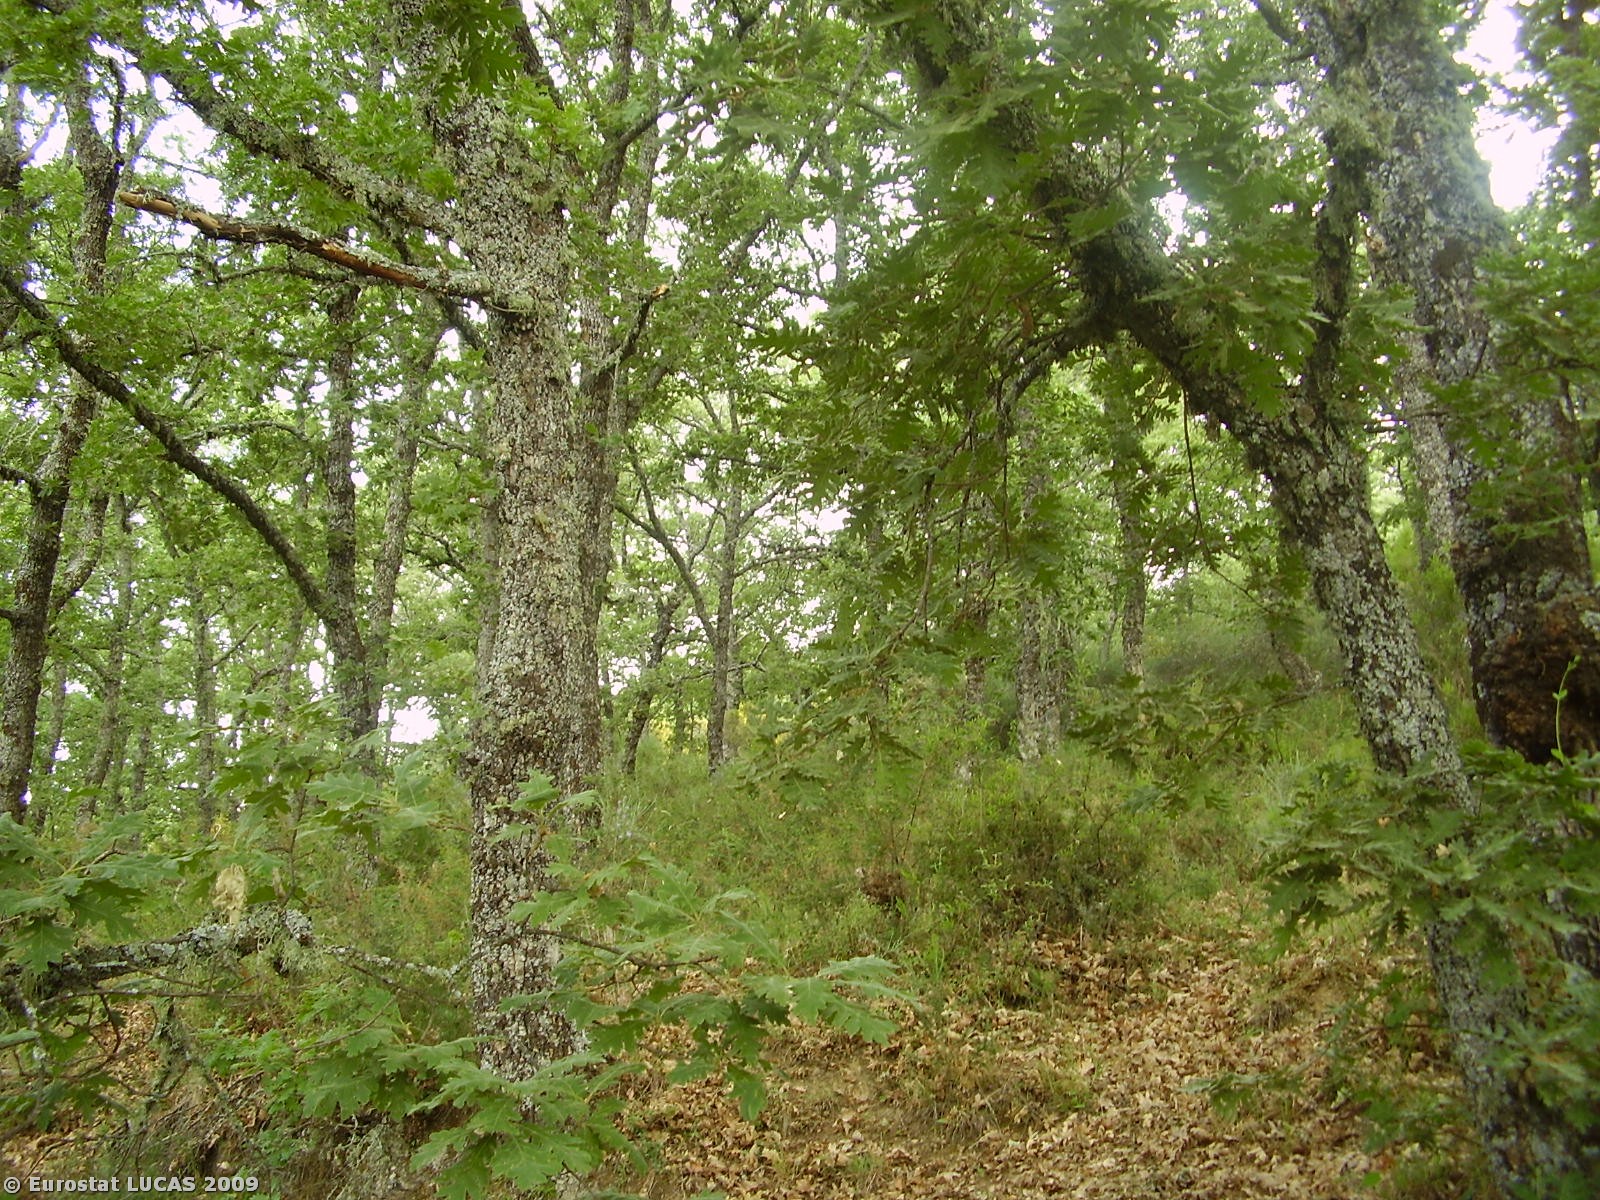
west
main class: Woodland
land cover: Broadleaved woodland
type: acidophilous oak and oak-birch forest
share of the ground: > 75 %
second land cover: Spontaneously vegetated surfaces
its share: 25 - 50 %
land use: Forestry
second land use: Nature reserves
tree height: > 5 m
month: June
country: PT
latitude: 41.7122
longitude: -6.8317
